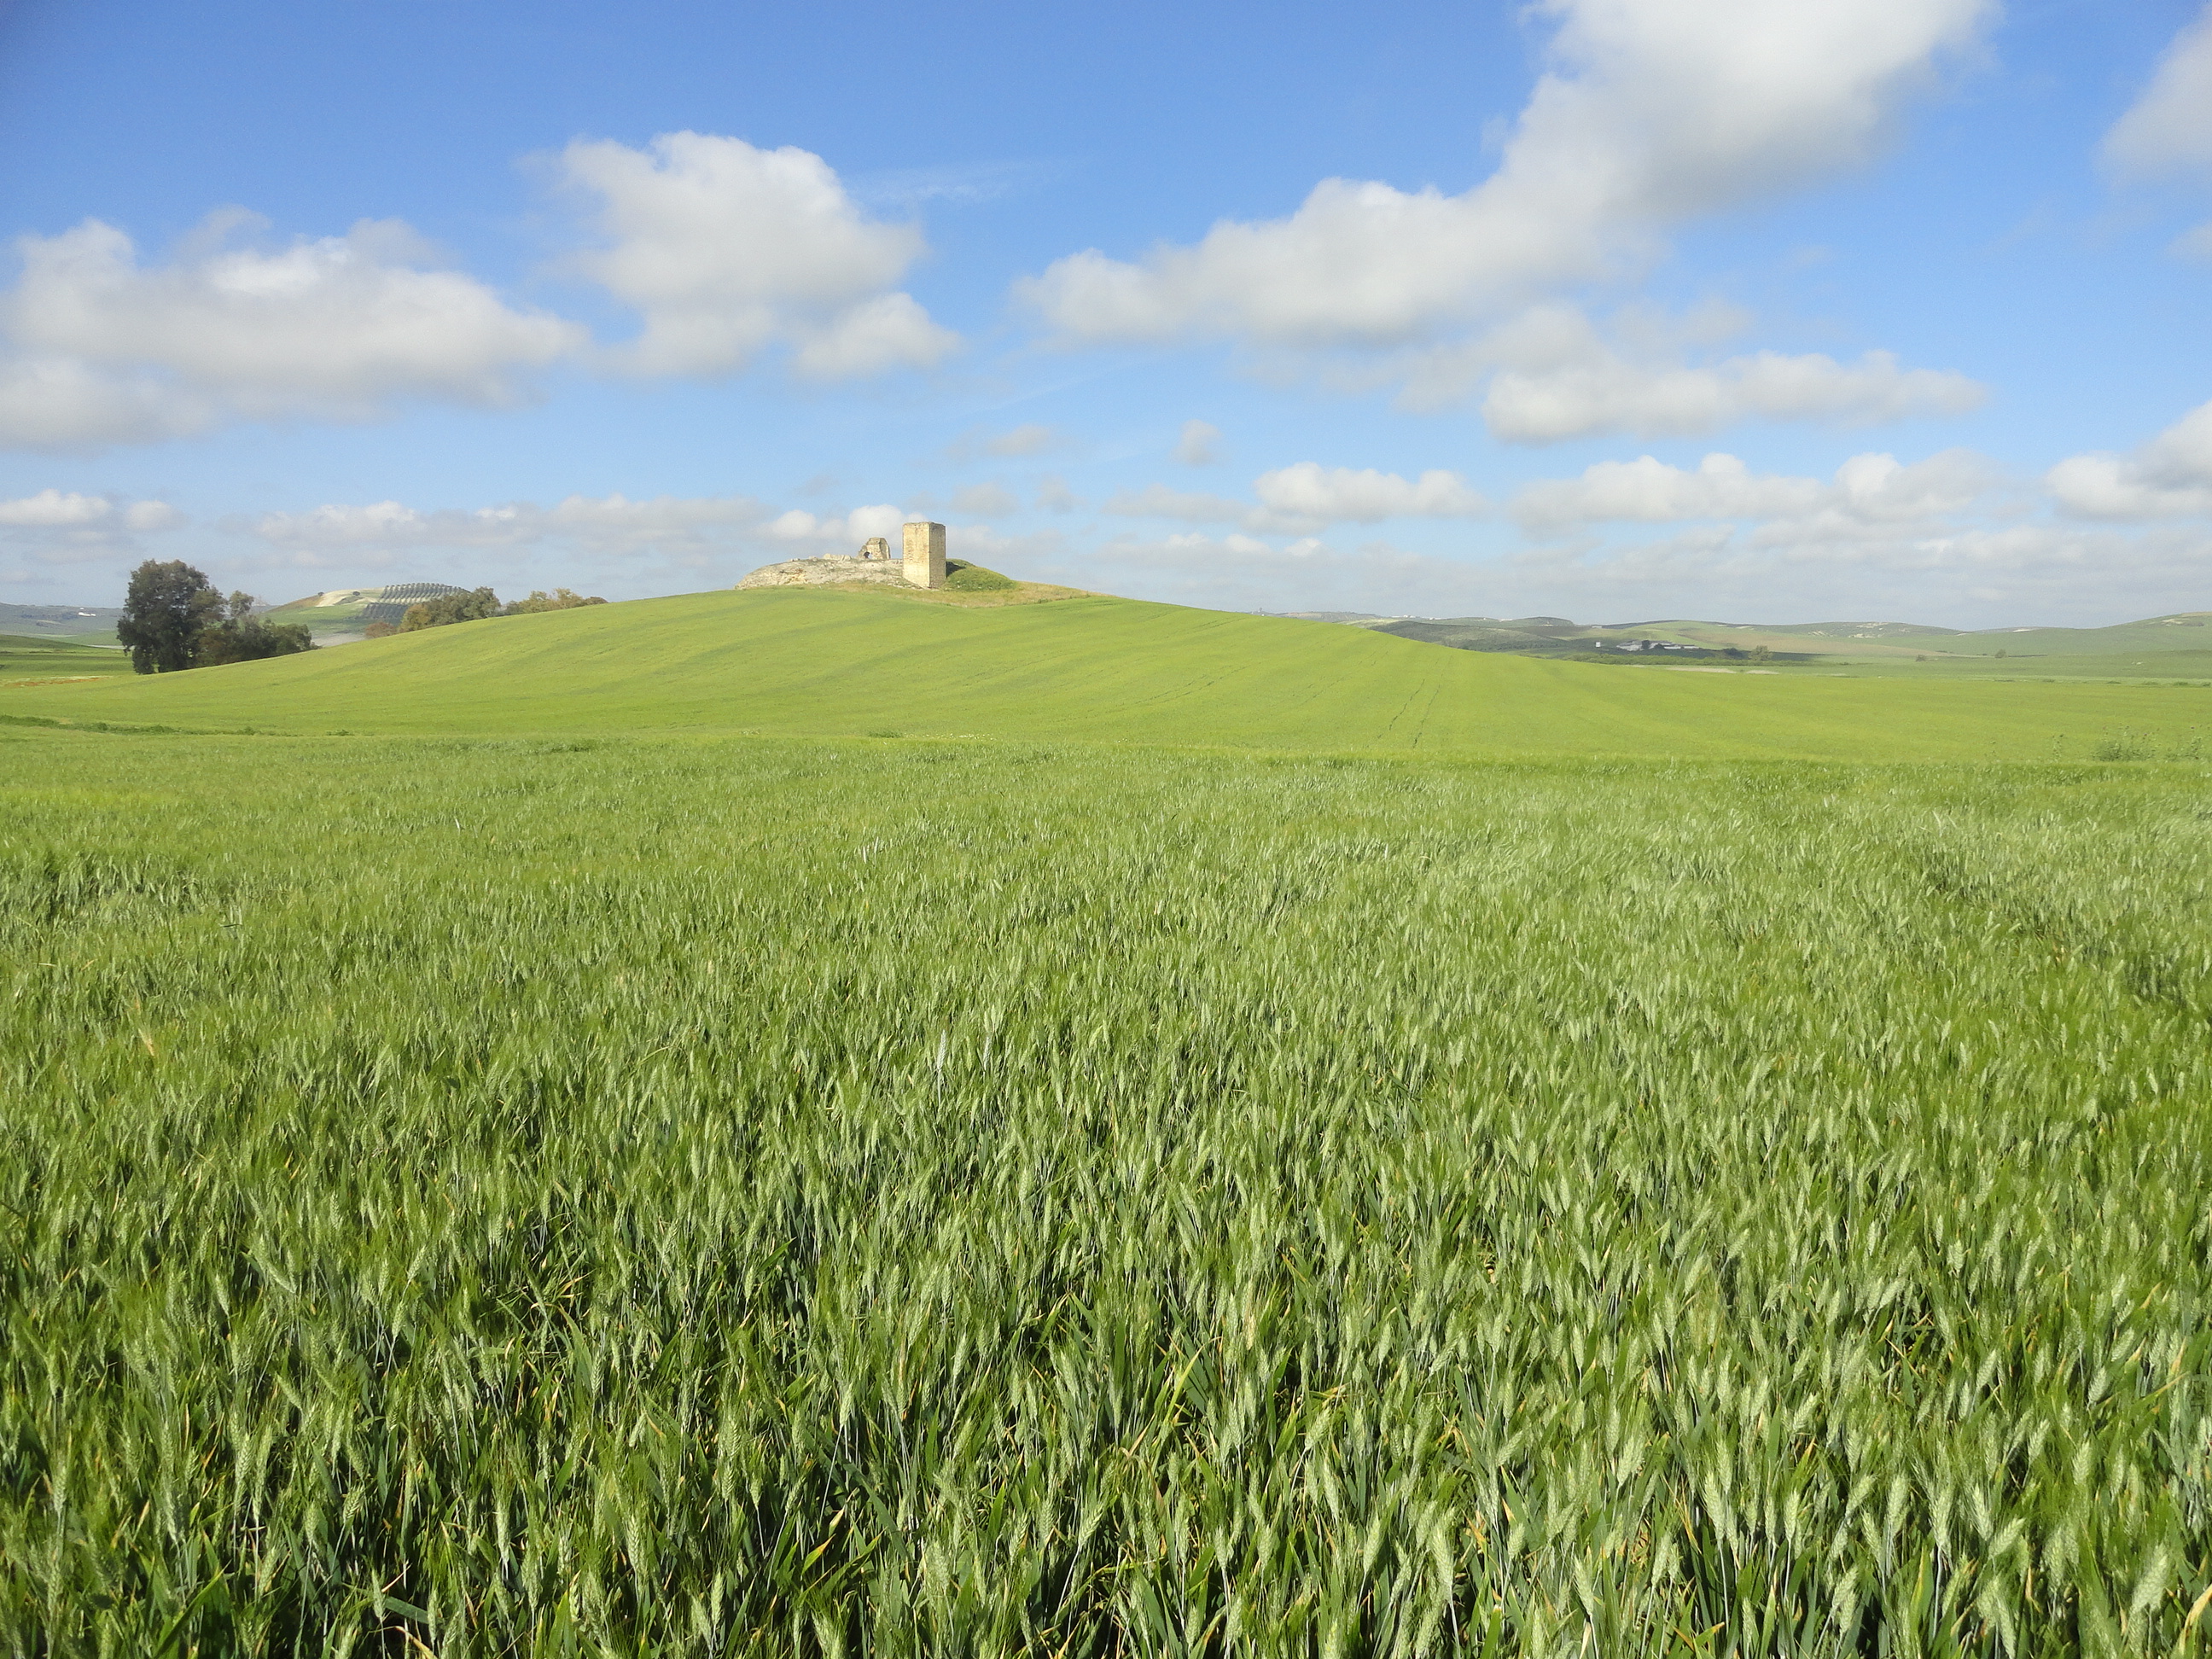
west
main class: Cropland
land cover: Durum wheat
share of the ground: > 75 %
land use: Agriculture (excluding fallow land and kitchen gardens)
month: April
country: ES
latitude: 37.6592
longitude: -4.6202
